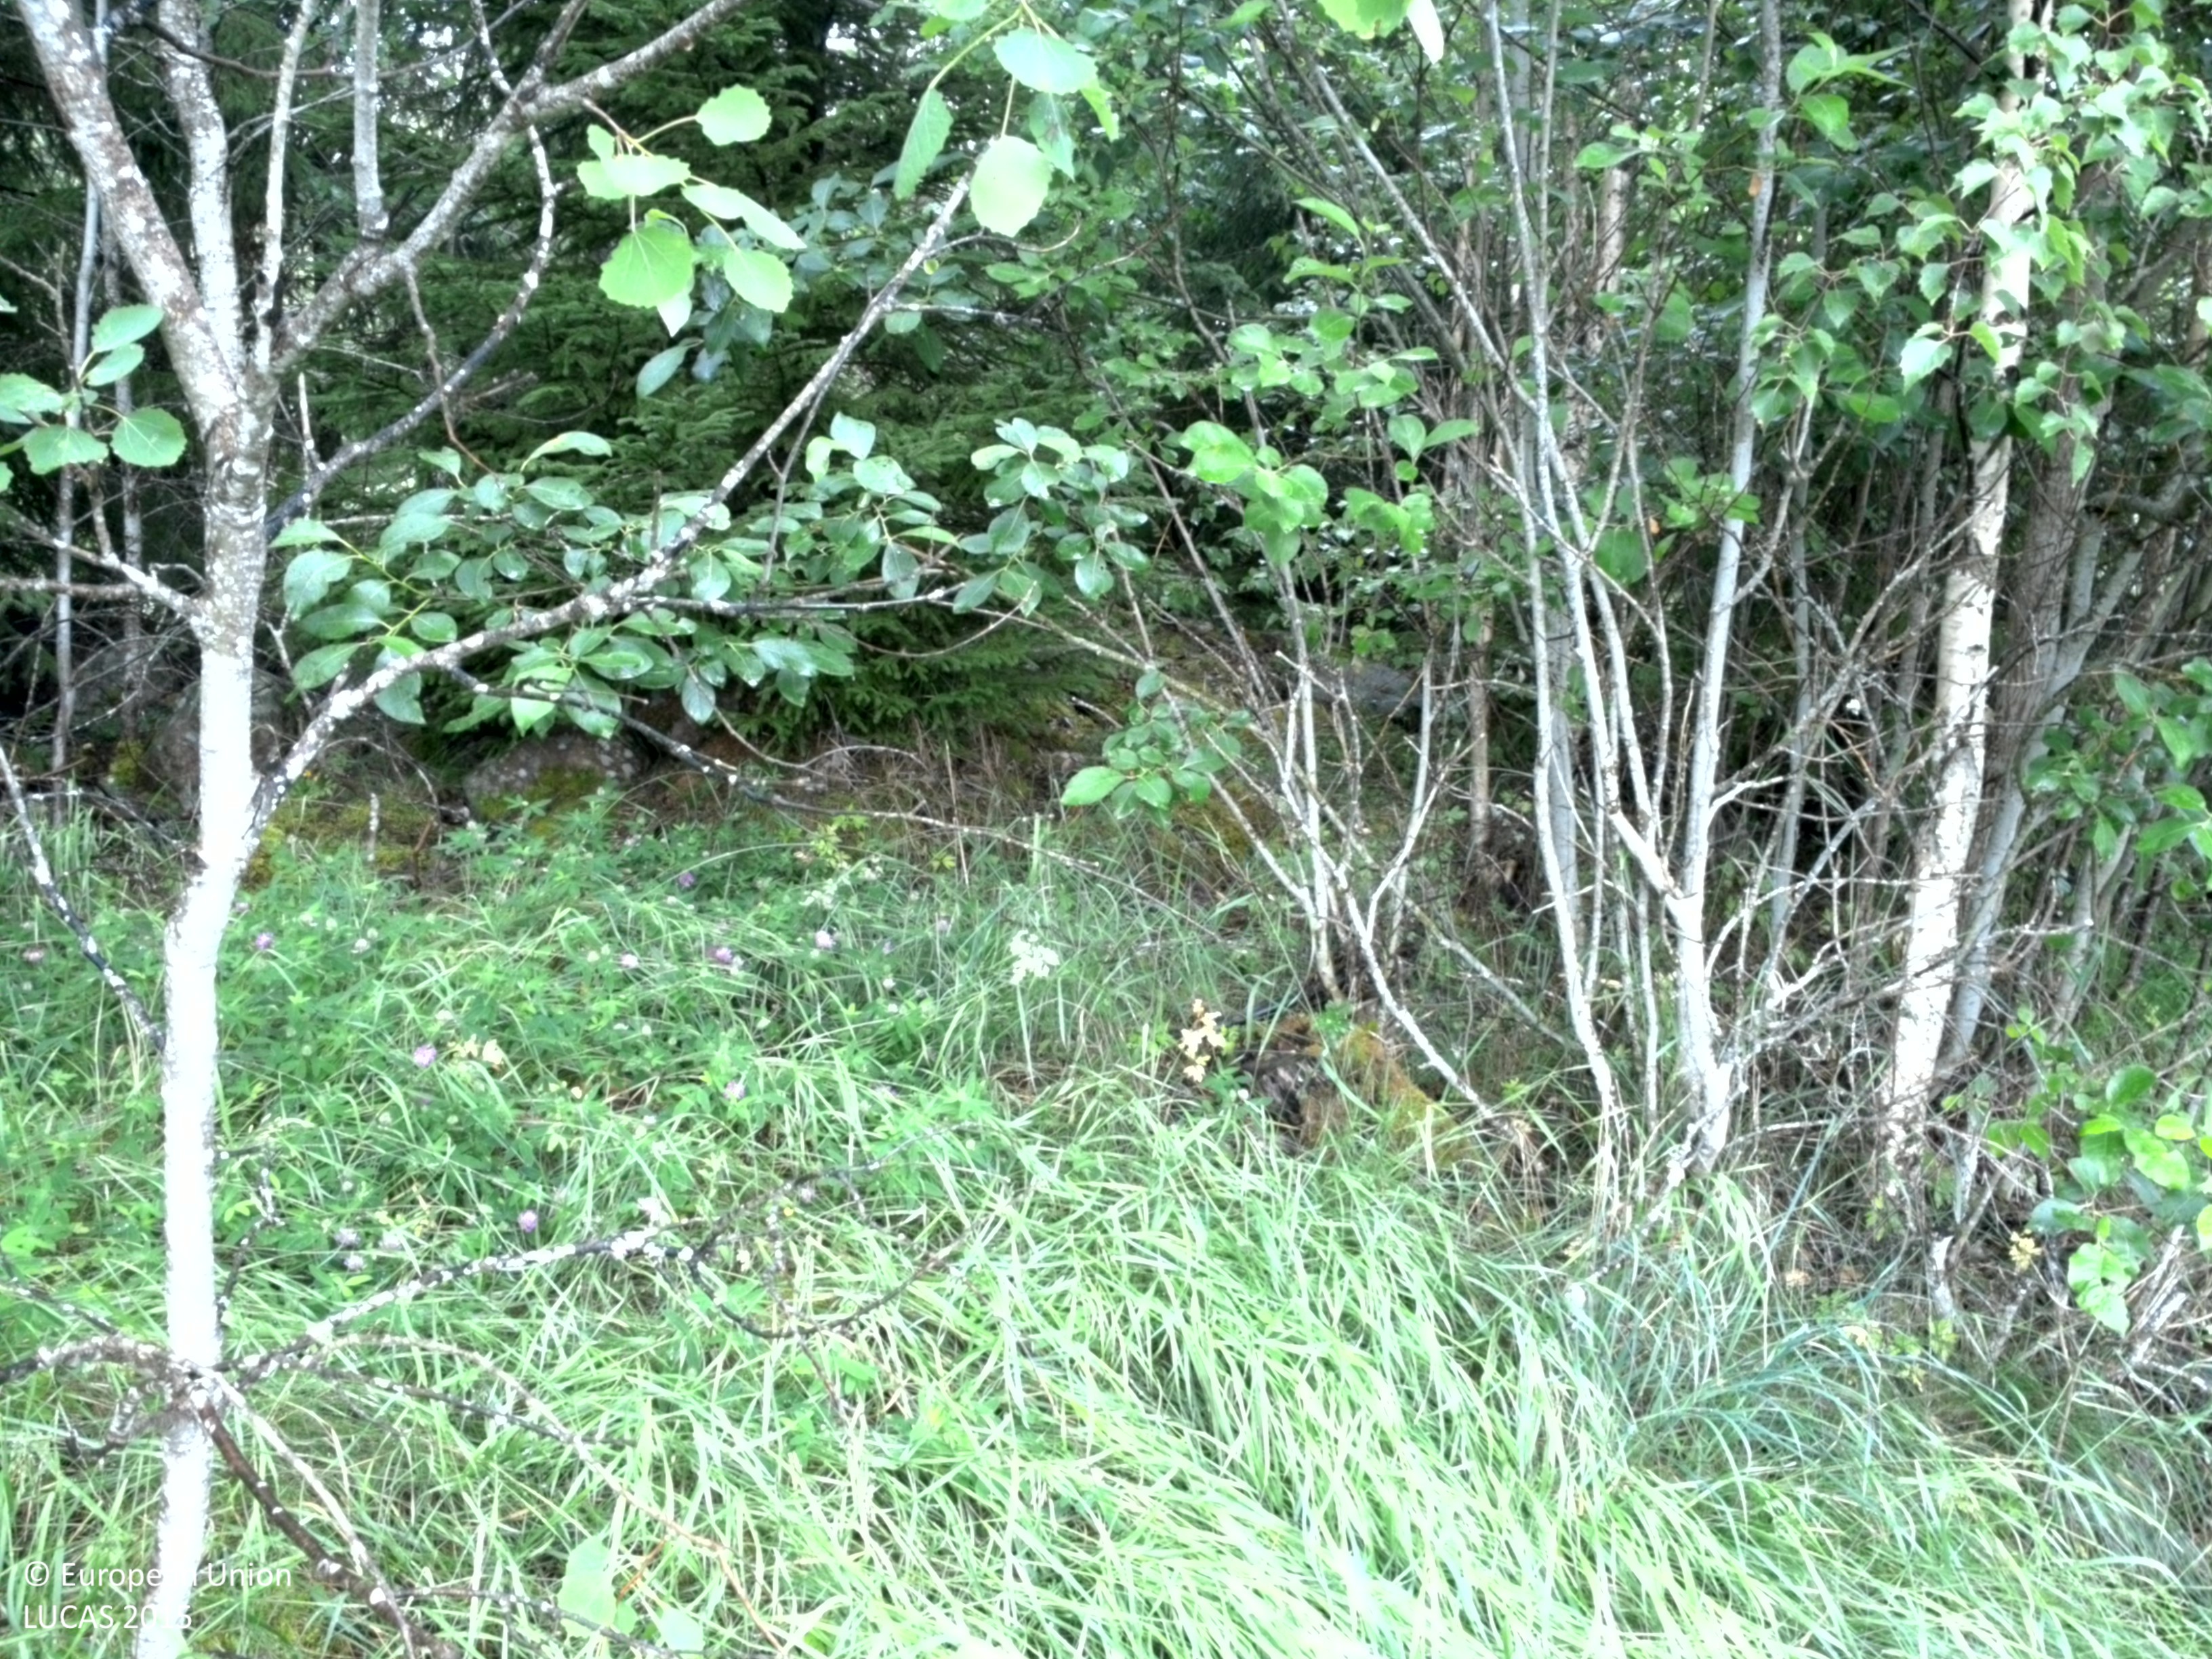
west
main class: Cropland
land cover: Common wheat
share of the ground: > 75 %
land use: Agriculture (excluding fallow land and kitchen gardens)
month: July
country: SE
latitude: 60.1229
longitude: 17.2085
